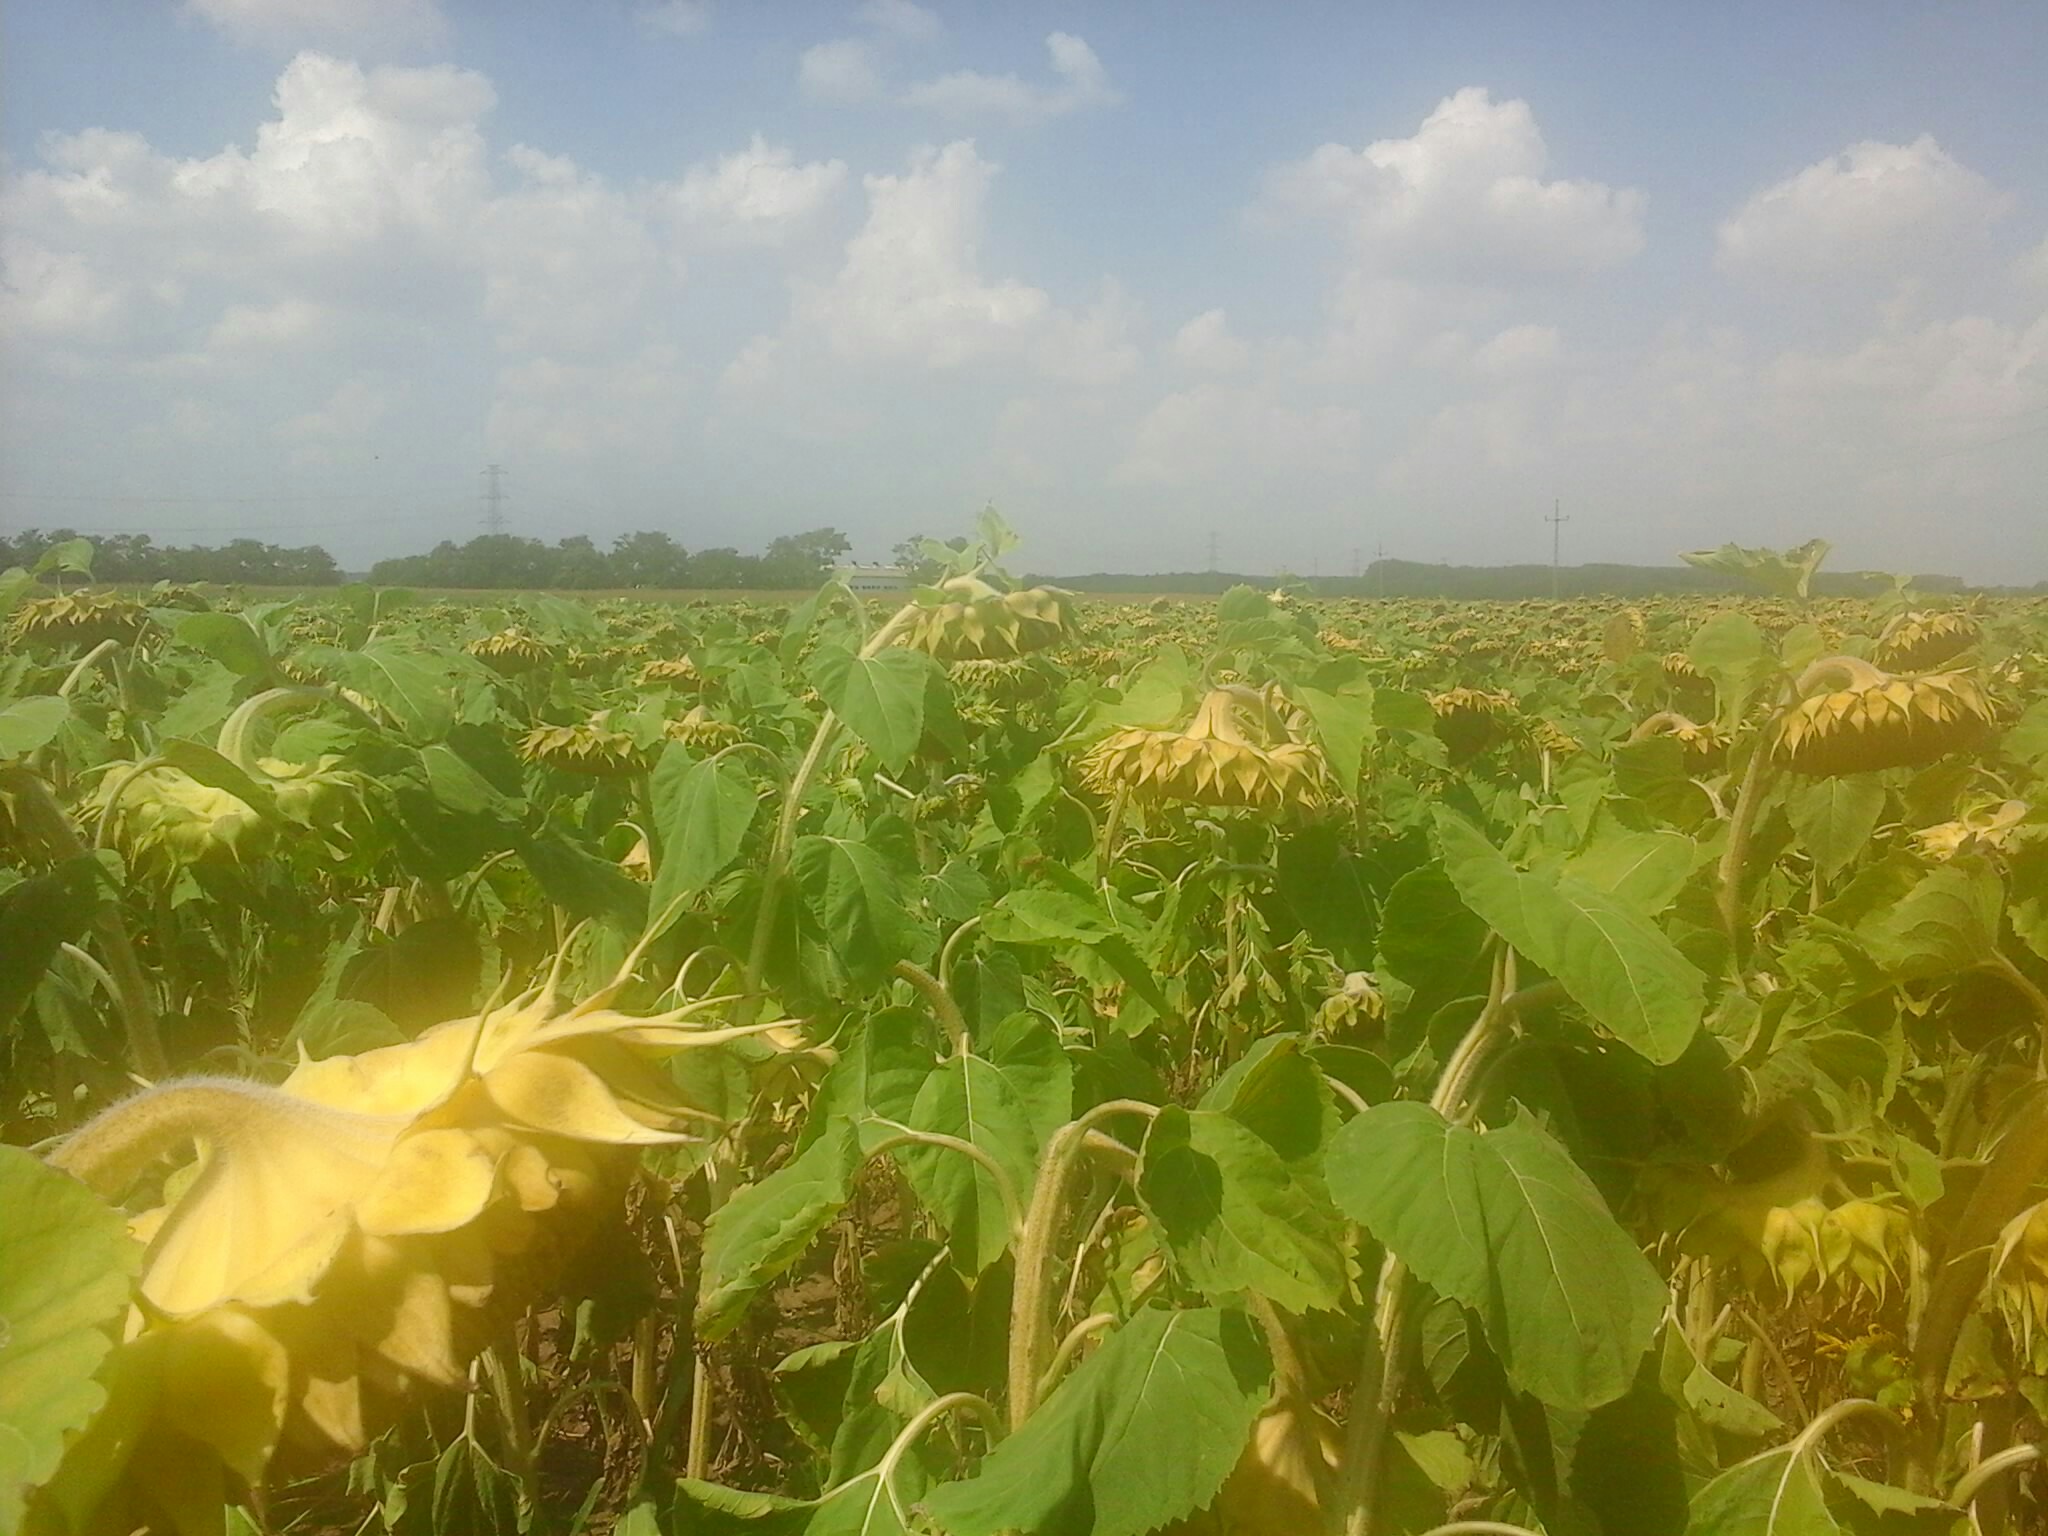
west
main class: Cropland
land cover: Sunflower
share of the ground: > 75 %
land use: Agriculture (excluding fallow land and kitchen gardens)
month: August
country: HU
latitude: 47.5907
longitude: 17.9764
